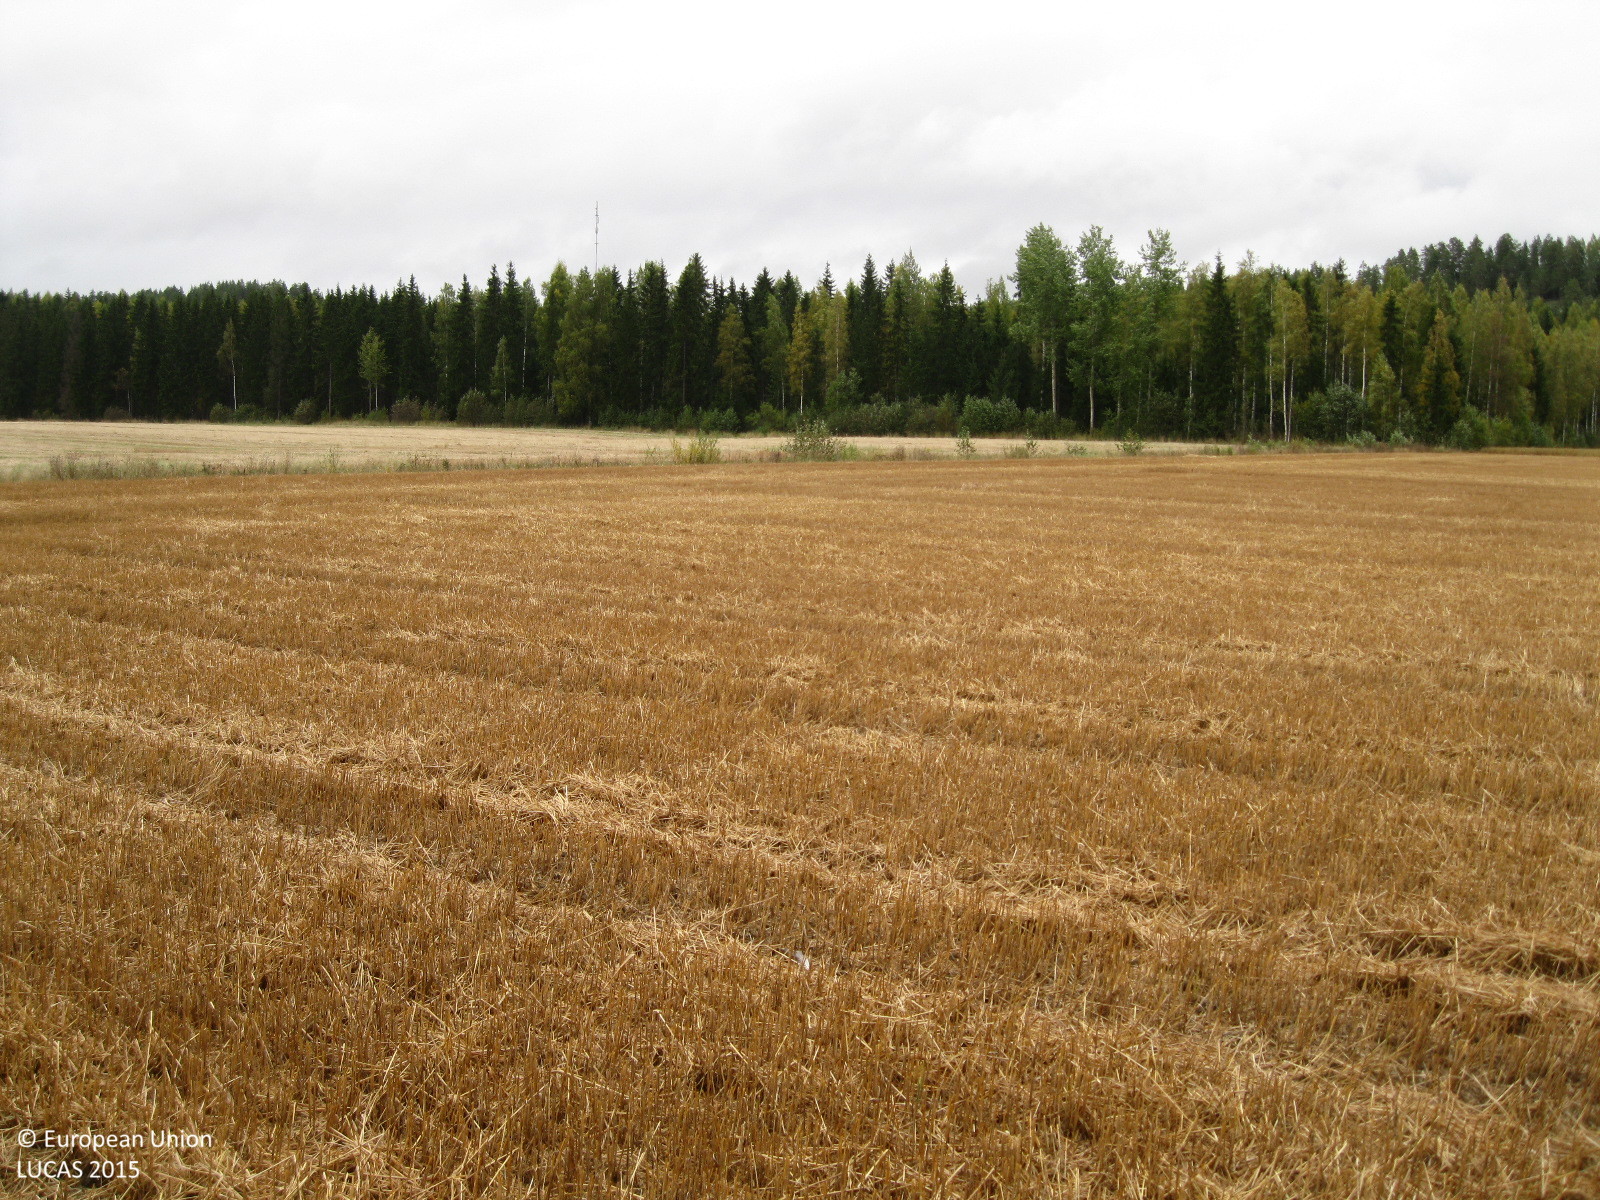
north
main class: Cropland
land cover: Barley
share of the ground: > 75 %
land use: Agriculture (excluding fallow land and kitchen gardens)
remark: Harvested field
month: September
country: FI
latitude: 60.8511
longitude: 24.7407
